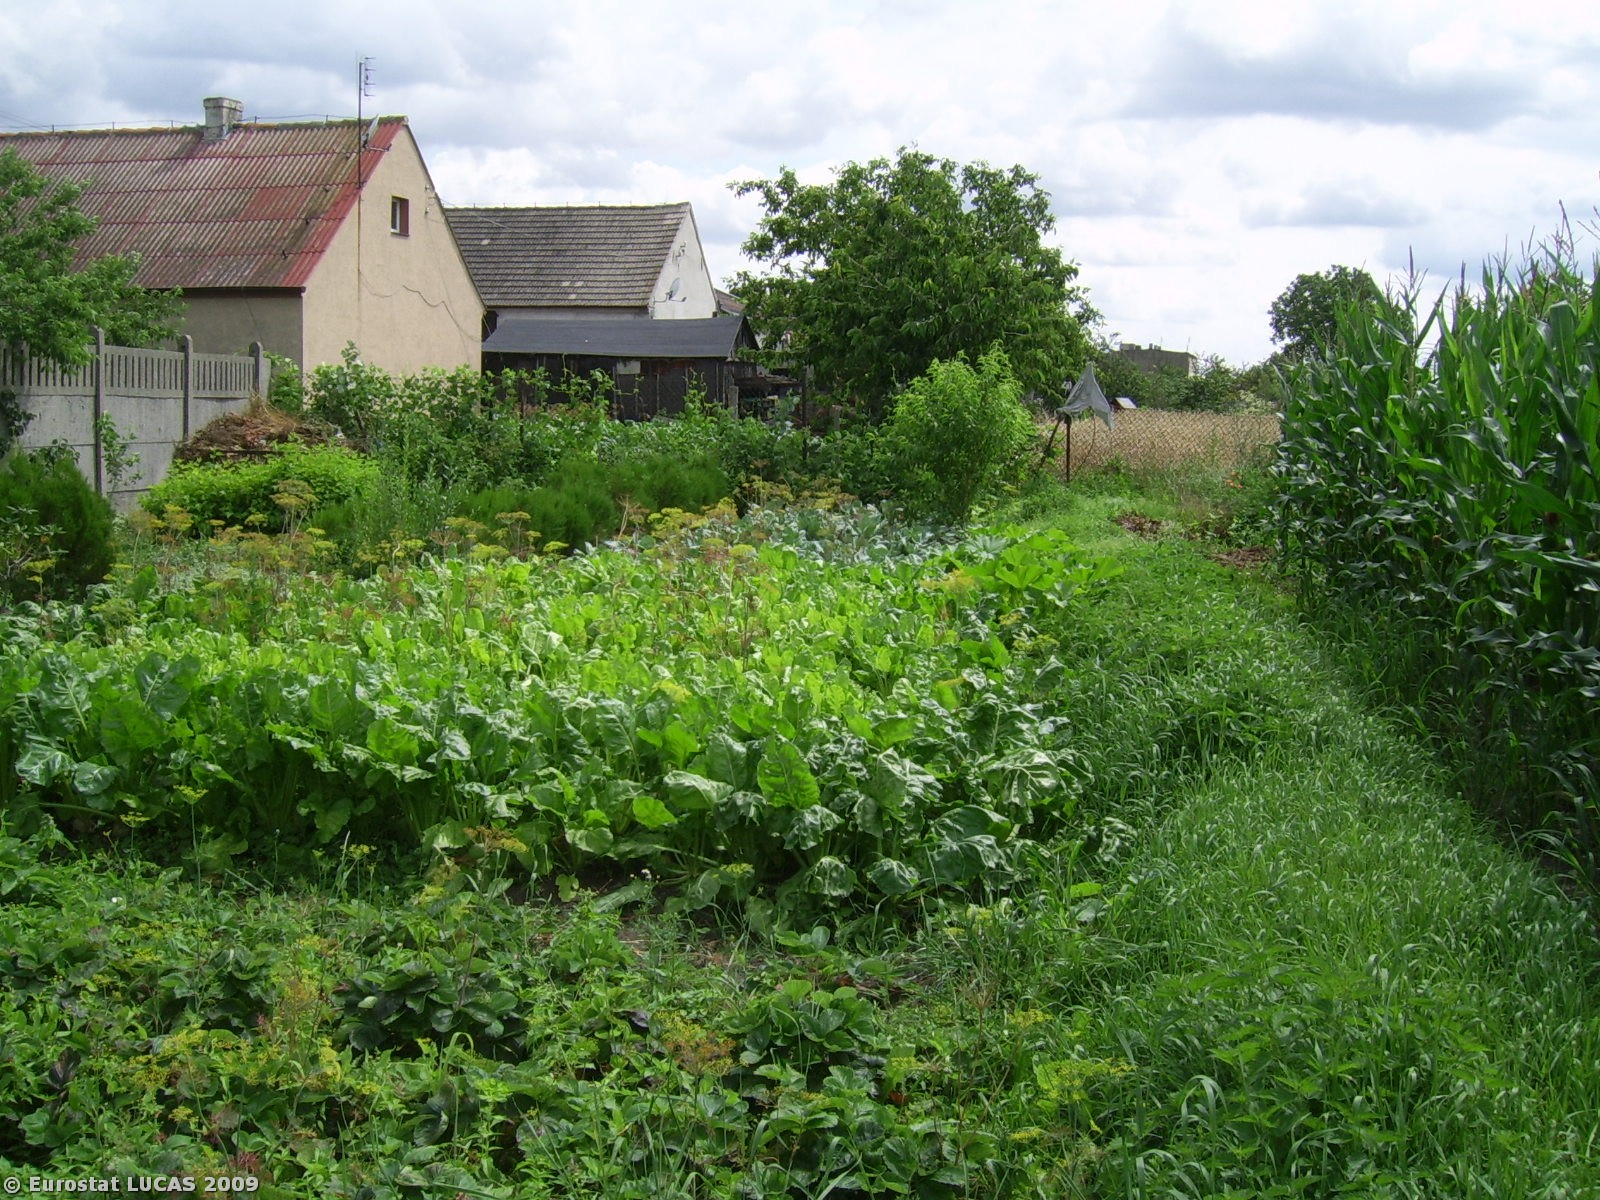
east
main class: Cropland
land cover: Maize
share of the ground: > 75 %
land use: Agriculture (excluding fallow land and kitchen gardens)
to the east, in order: Maize; Grass margins; Fences; Artificial constructions in urban areas; Fences; Grass margins; Electric lines; Ditches and canals; Grass margins; Paved roads, cycling and walking lanes; Grass margins; Ditches and canals; Grassland without tree/shrub cover; Ditches and canals; Grassland without tree/shrub cover
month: July
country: PL
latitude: 51.6566
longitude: 16.8466
